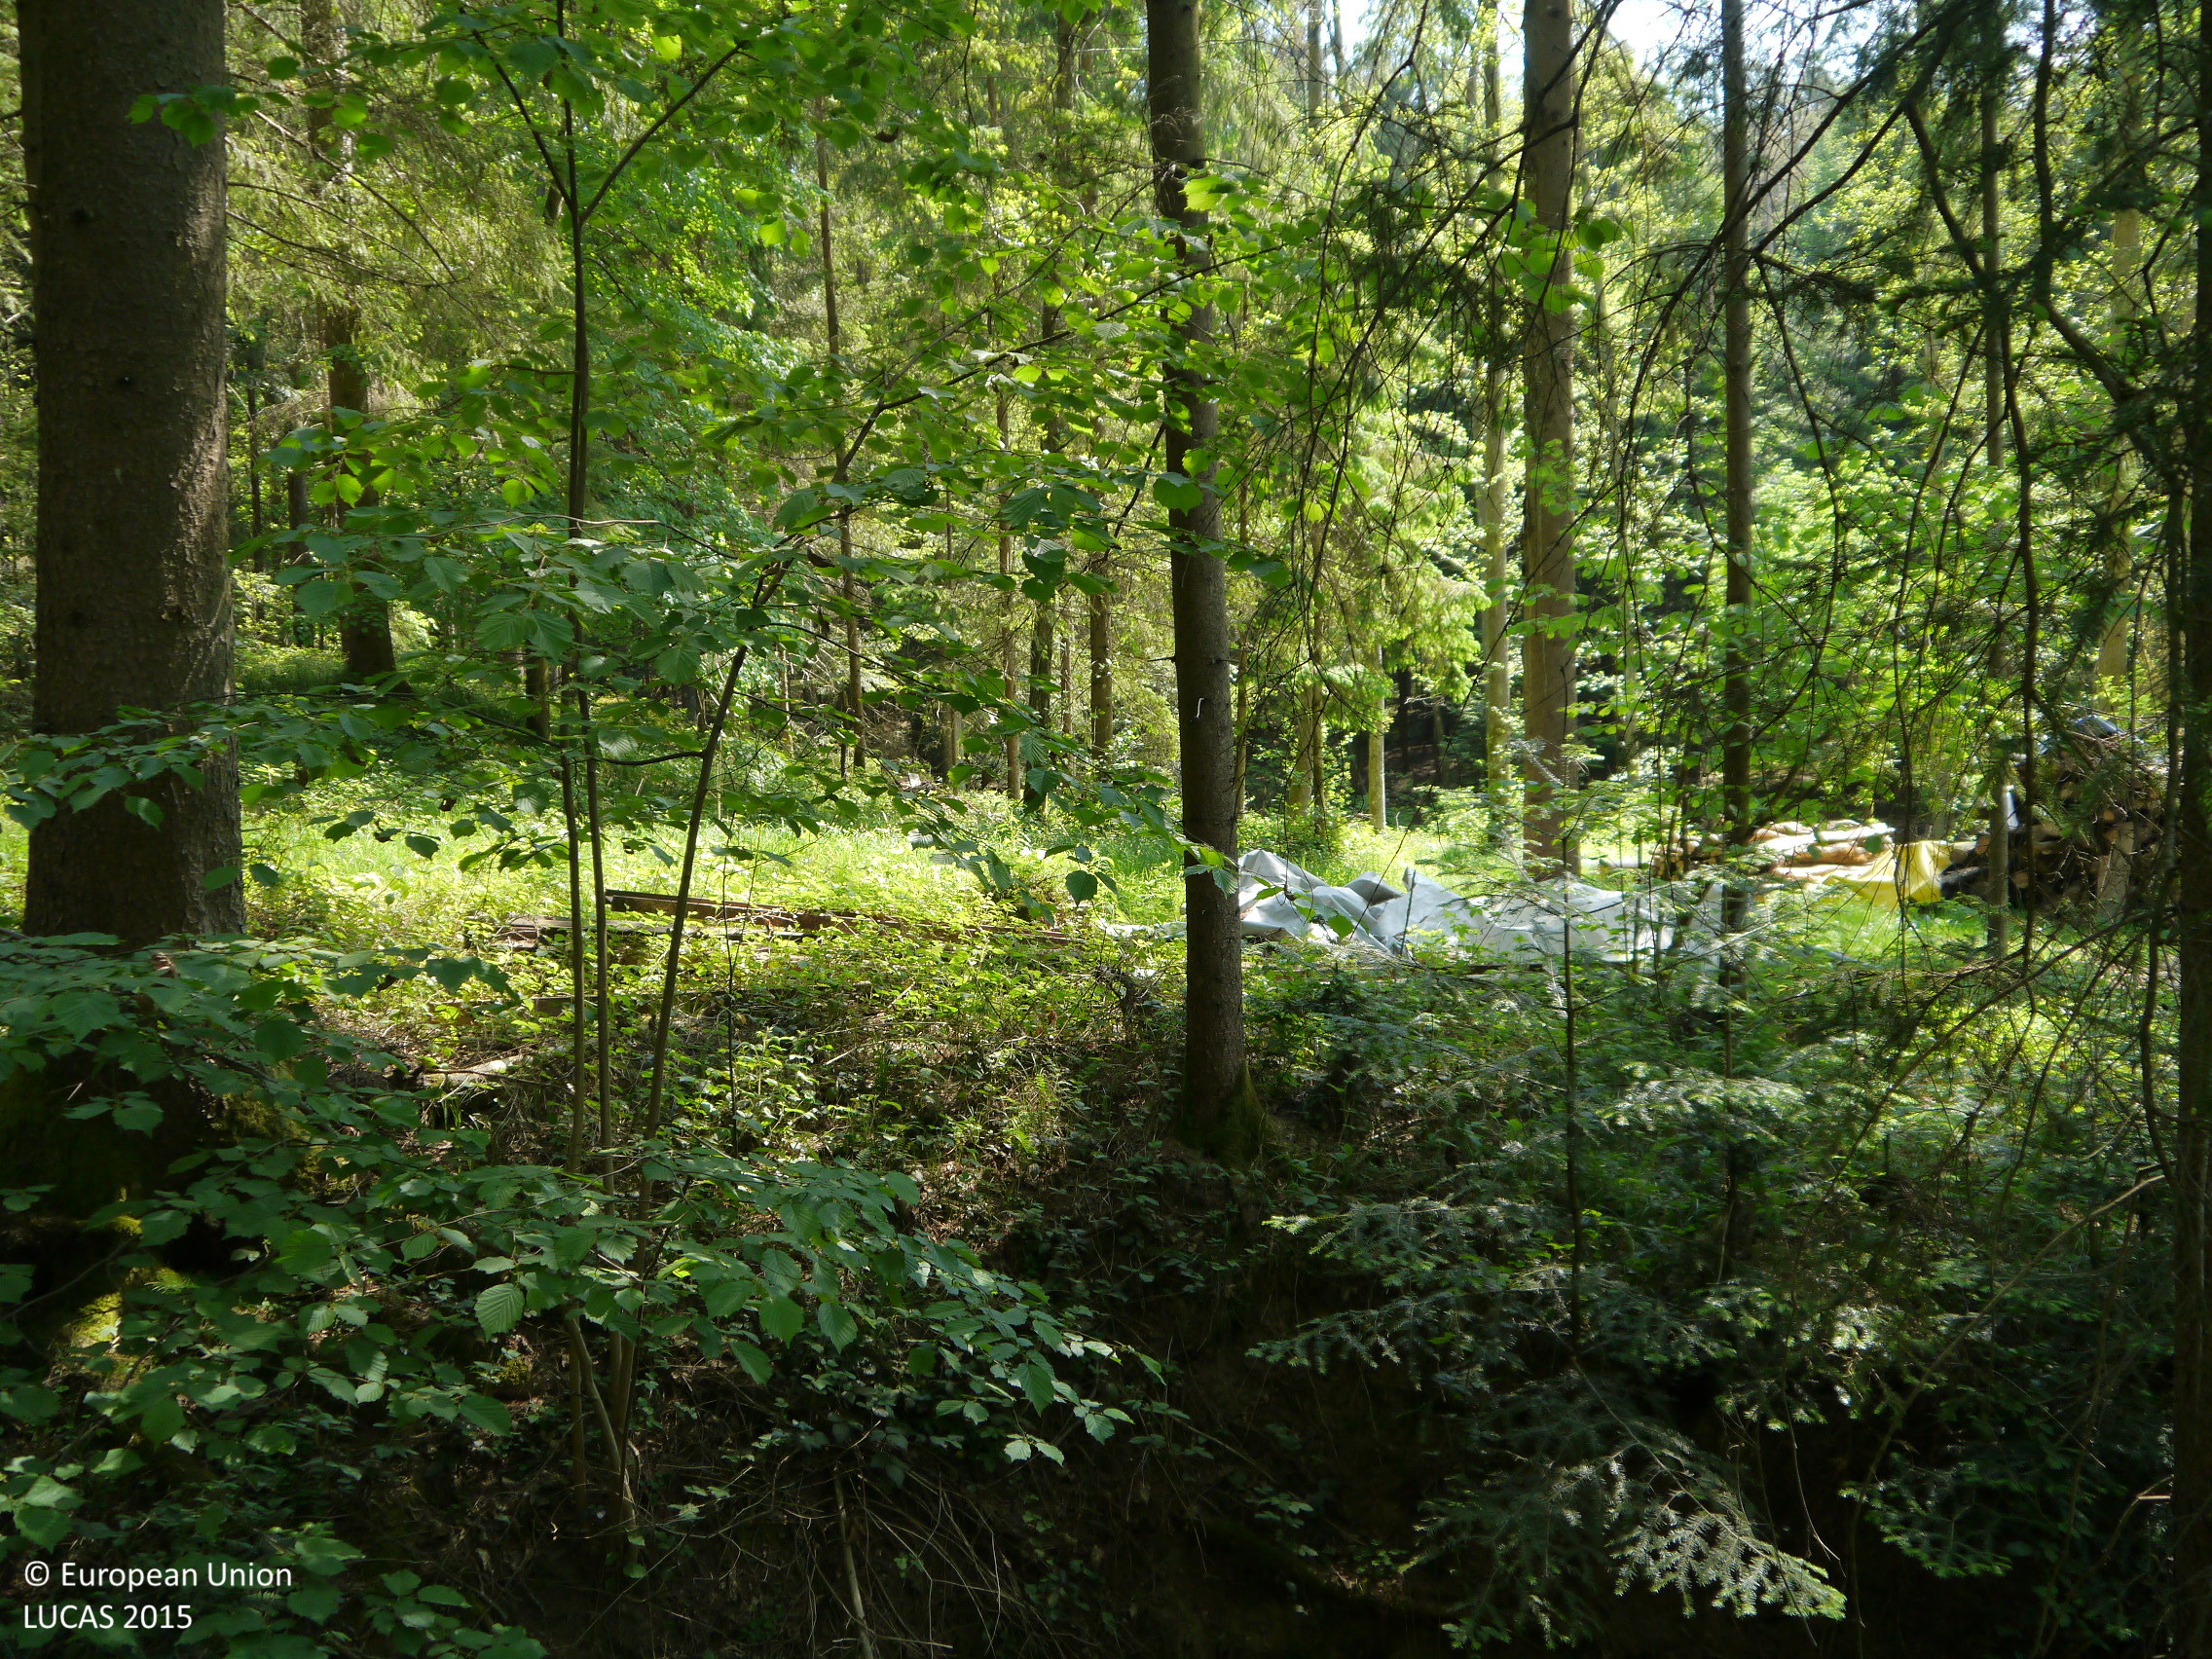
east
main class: Woodland
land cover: Spruce dominated coniferous woodland
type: hemiboreal forest and nemoral coniferous forest and mixed broadleaved-coniferous forest
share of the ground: > 75 %
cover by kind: coniferous forest trees 80 %, herbaceous plants 10 %, broadleaved forest trees 5 %, shrubs 5 %
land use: Forestry
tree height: > 5 m
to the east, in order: Spruce dominated coniferous woodland; Rivers and streams; Spruce dominated coniferous woodland; Tracks; Spruce dominated coniferous woodland; Rivers and streams; Spruce dominated coniferous woodland; Tracks; Pine dominated coniferous woodland; Tracks; Pine dominated coniferous woodland
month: May
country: AT
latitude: 46.9959
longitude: 15.2989
